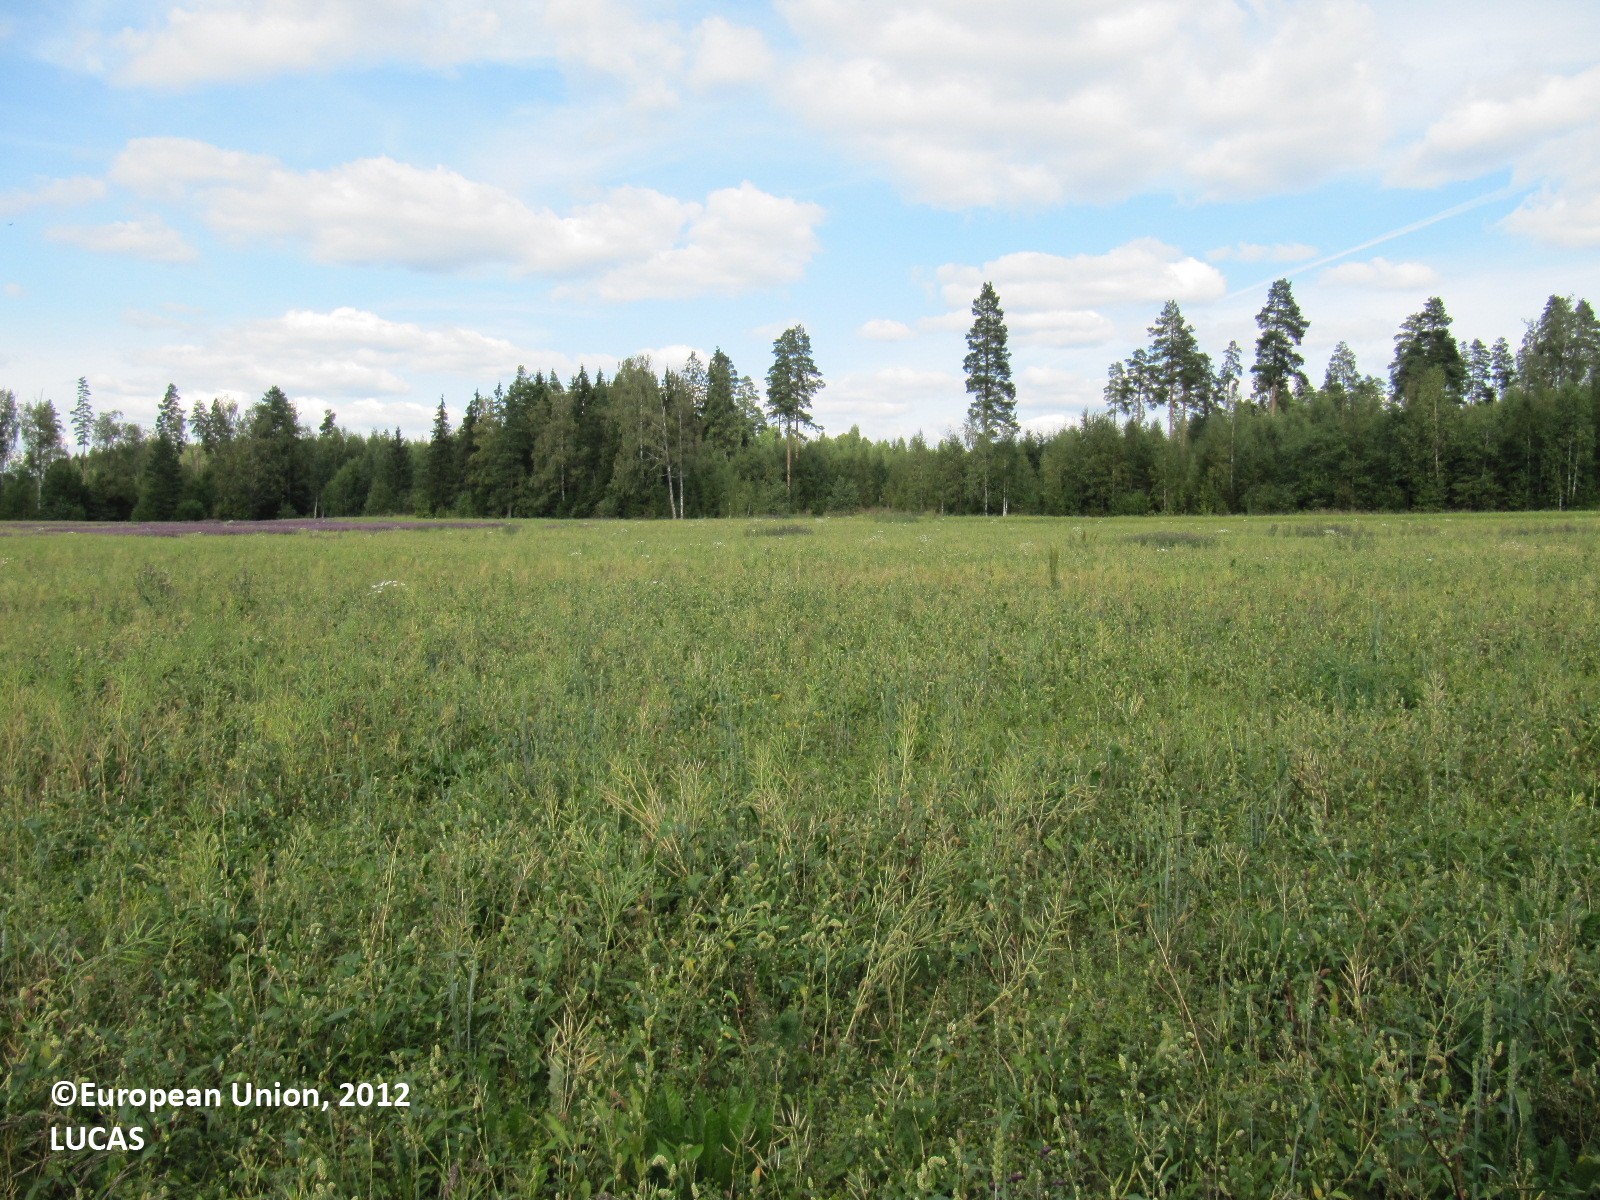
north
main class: Cropland
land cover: Dry pulses
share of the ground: > 75 %
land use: Agriculture (excluding fallow land and kitchen gardens)
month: August
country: FI
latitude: 60.3919
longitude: 24.3849
